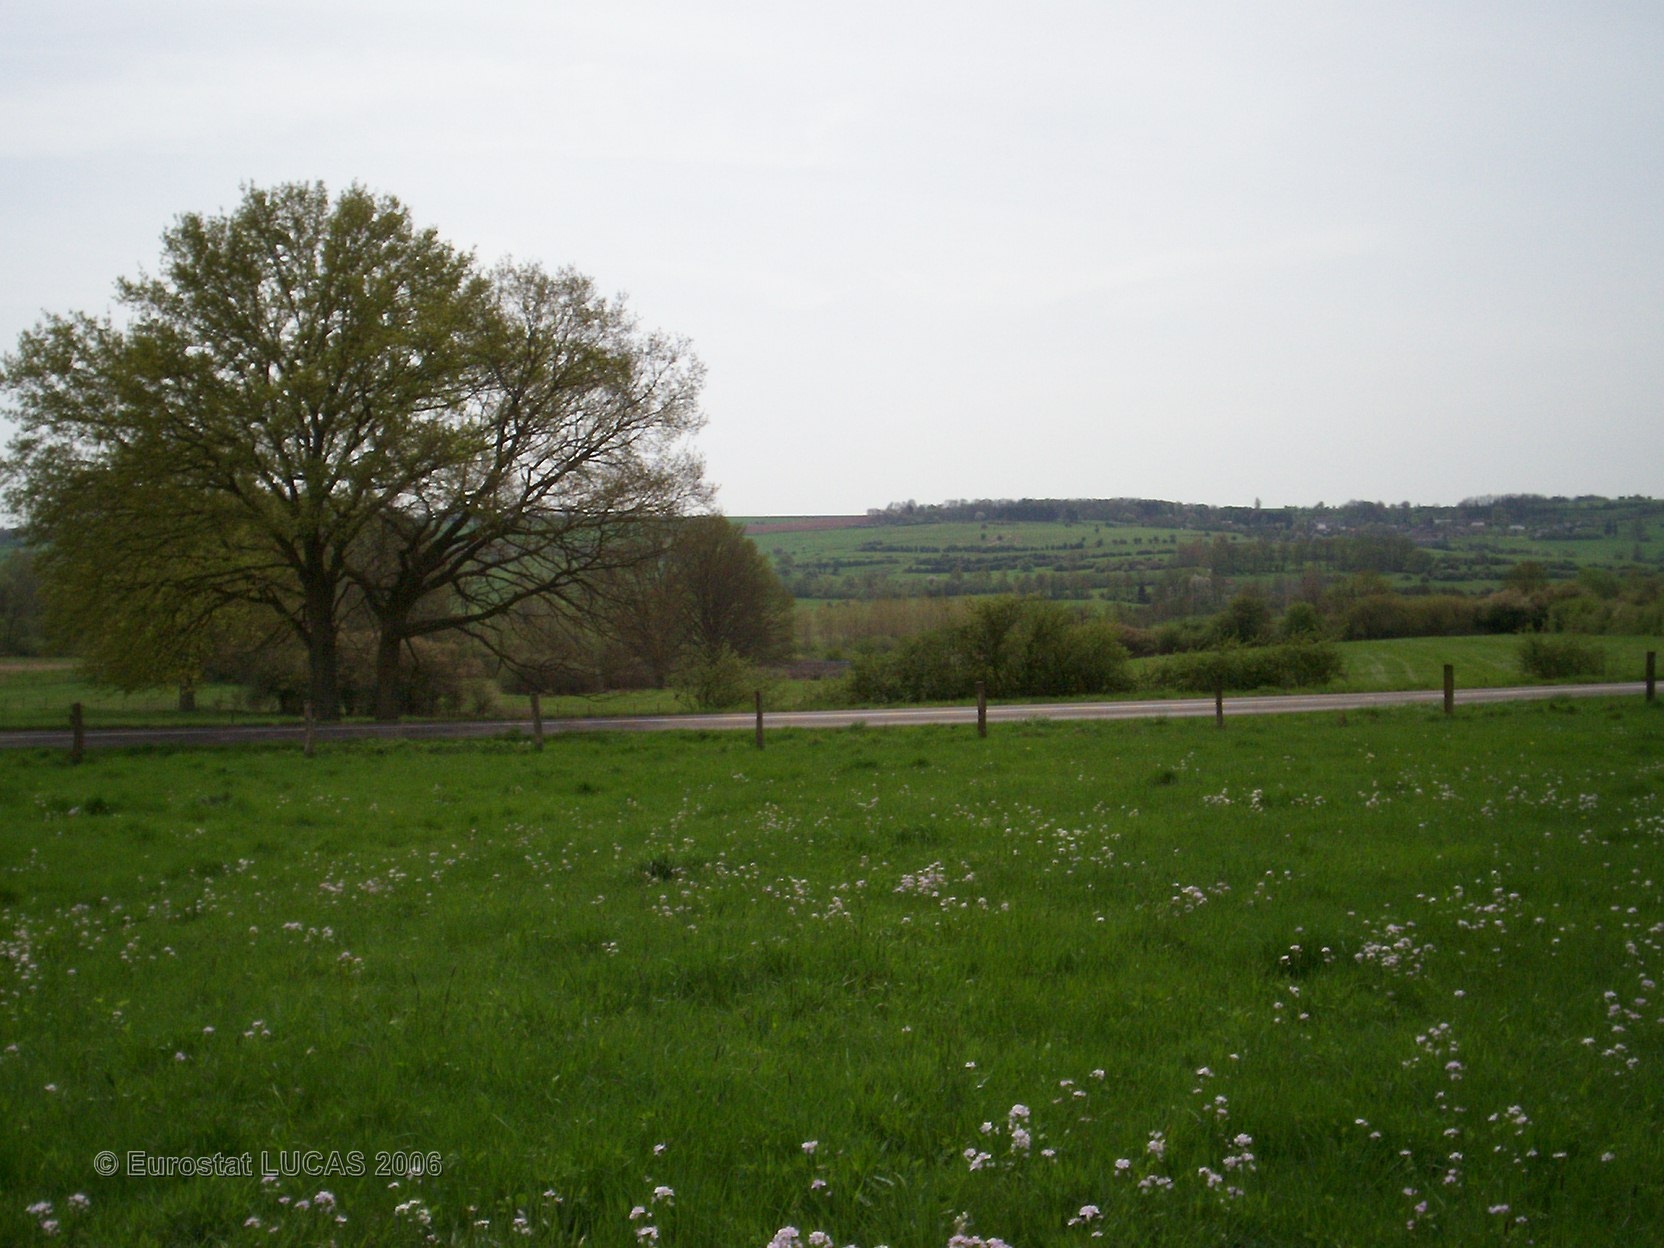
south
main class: Grassland
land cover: Grassland without tree/shrub cover
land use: Agriculture (excluding fallow land and kitchen gardens)
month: May
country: FR
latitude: 49.8009
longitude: 4.5360
